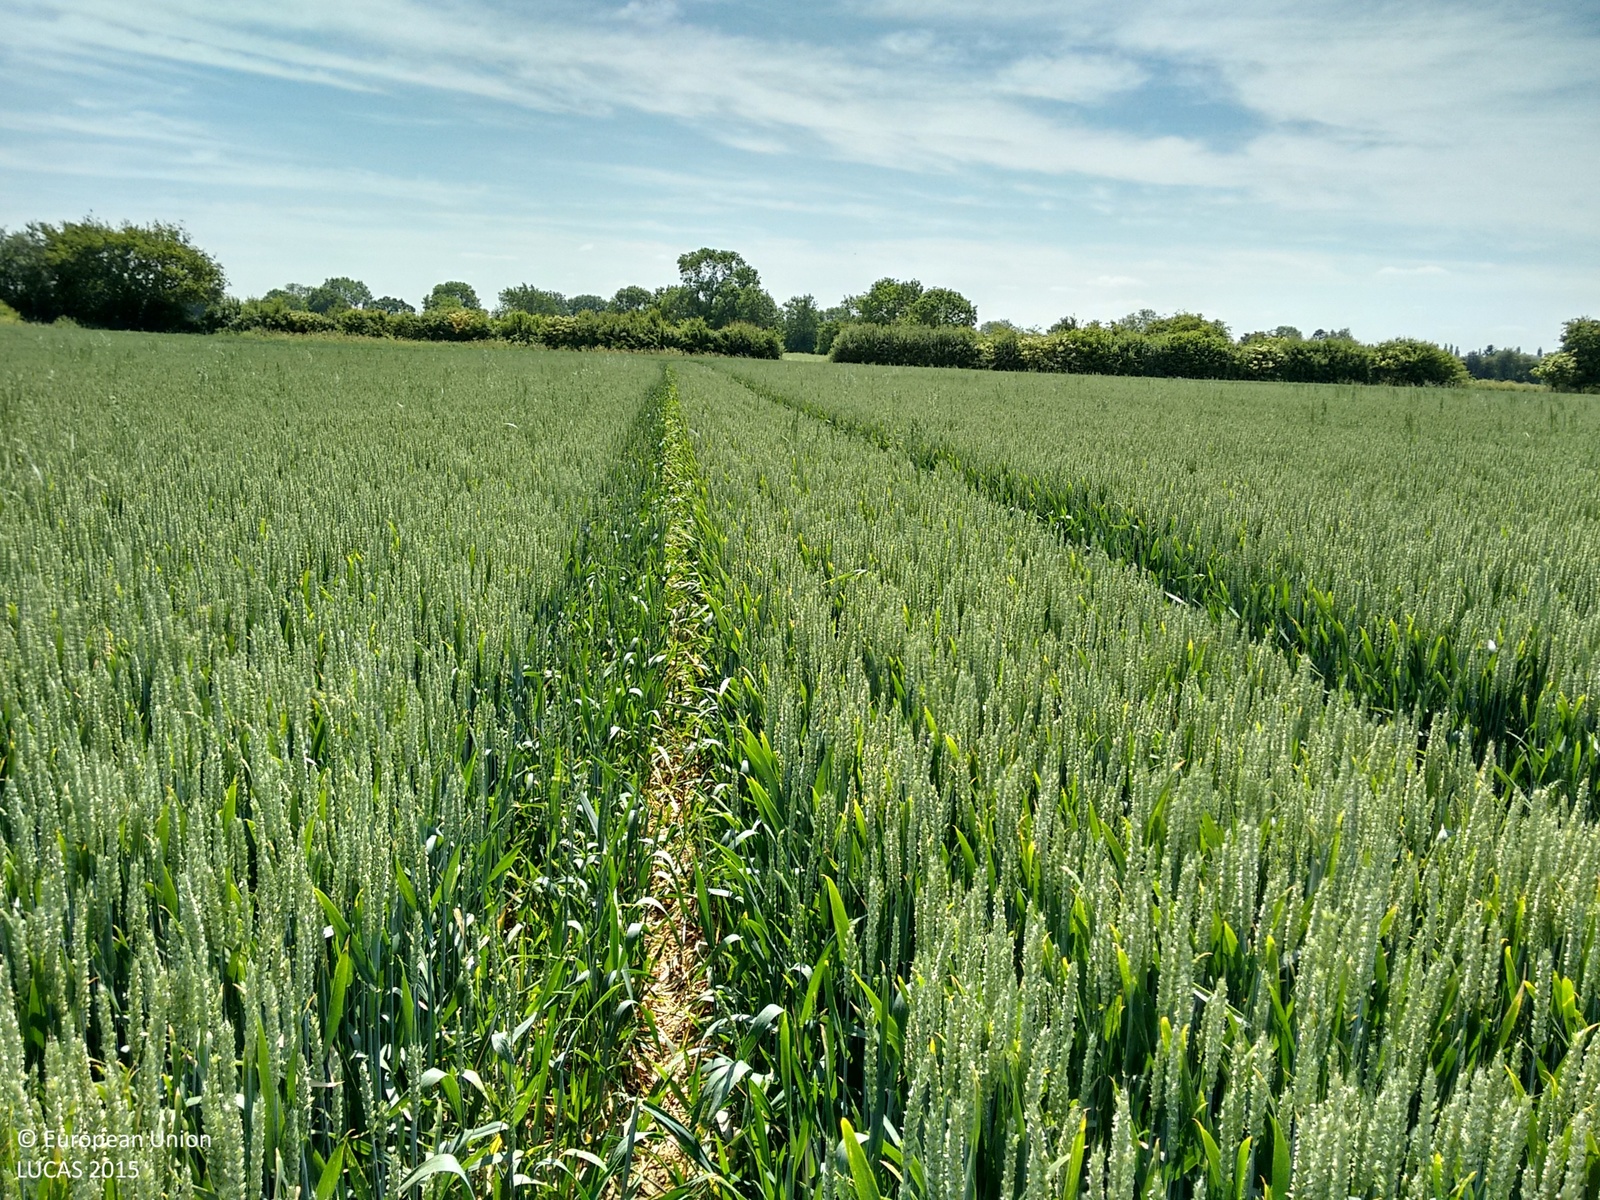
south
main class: Cropland
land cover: Common wheat
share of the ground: > 75 %
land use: Agriculture (excluding fallow land and kitchen gardens)
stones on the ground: < 10 %
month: June
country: GB
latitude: 51.8391
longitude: -1.2671
